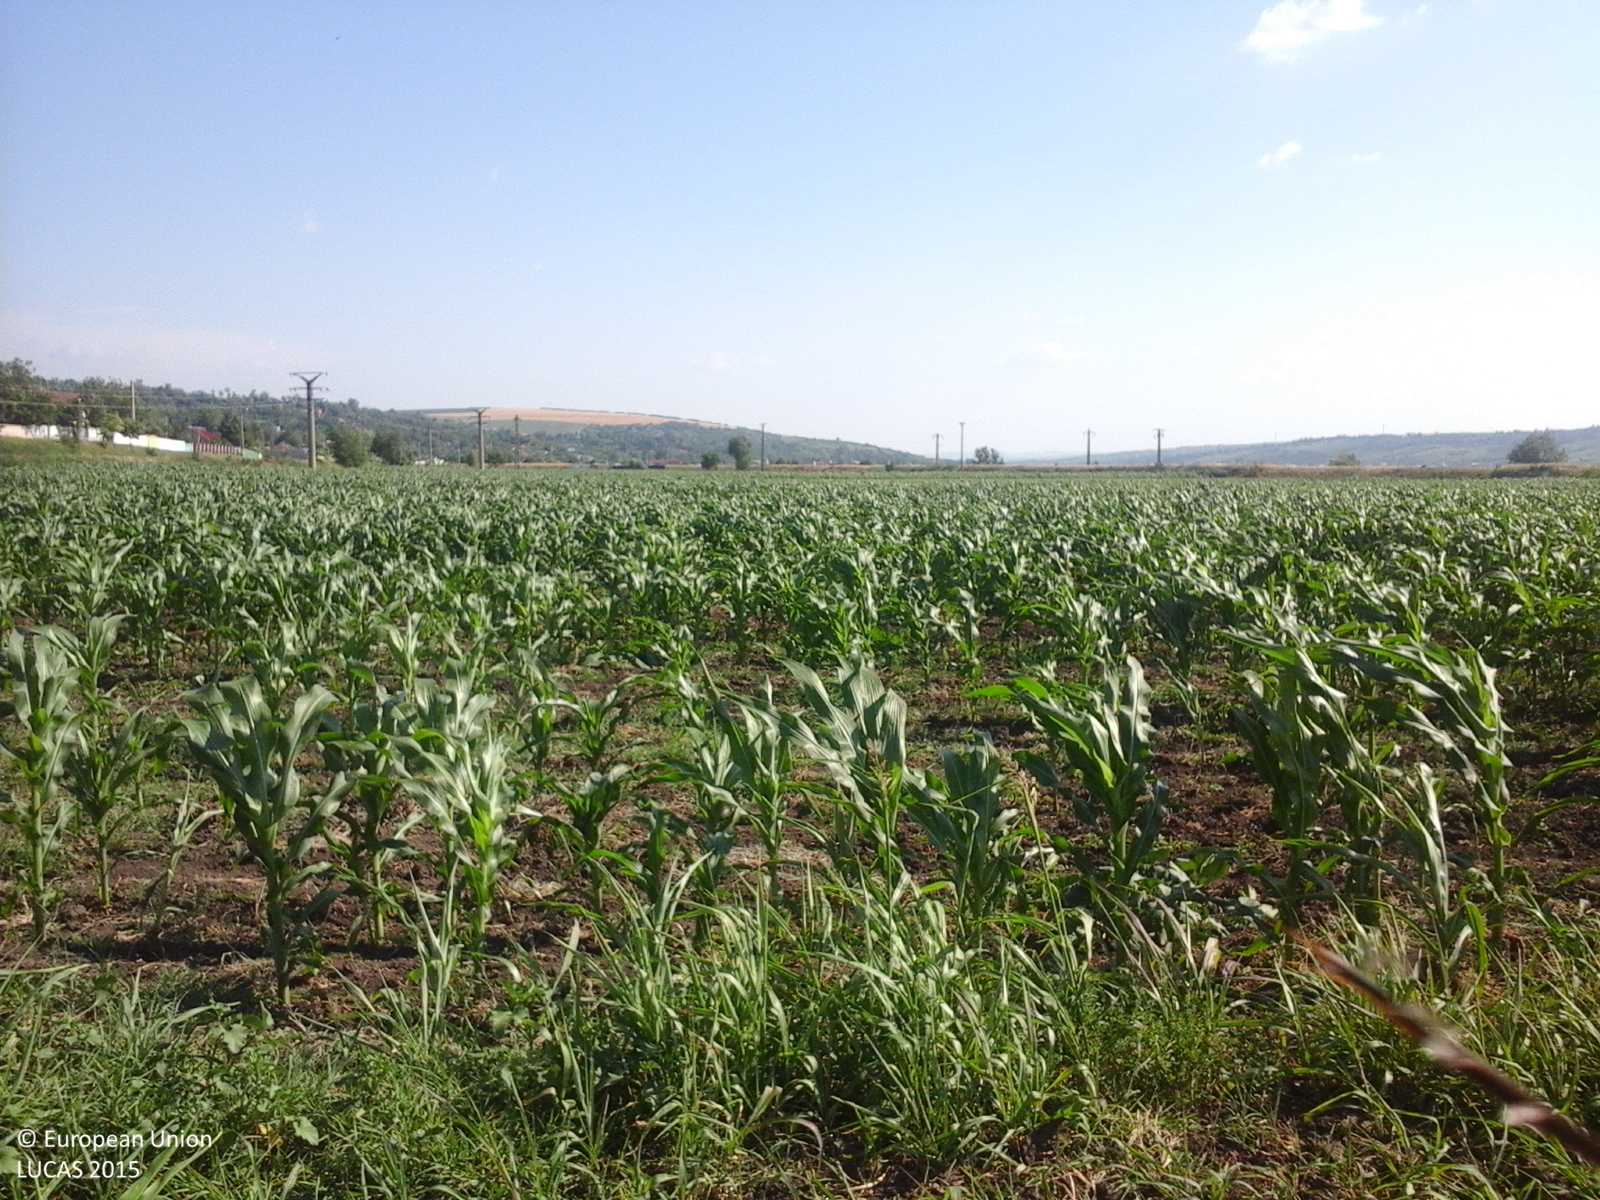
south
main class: Cropland
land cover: Maize
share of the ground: 10 - 25 %
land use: Agriculture (excluding fallow land and kitchen gardens)
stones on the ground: < 10 %
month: June
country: RO
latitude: 46.7790
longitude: 27.7903
